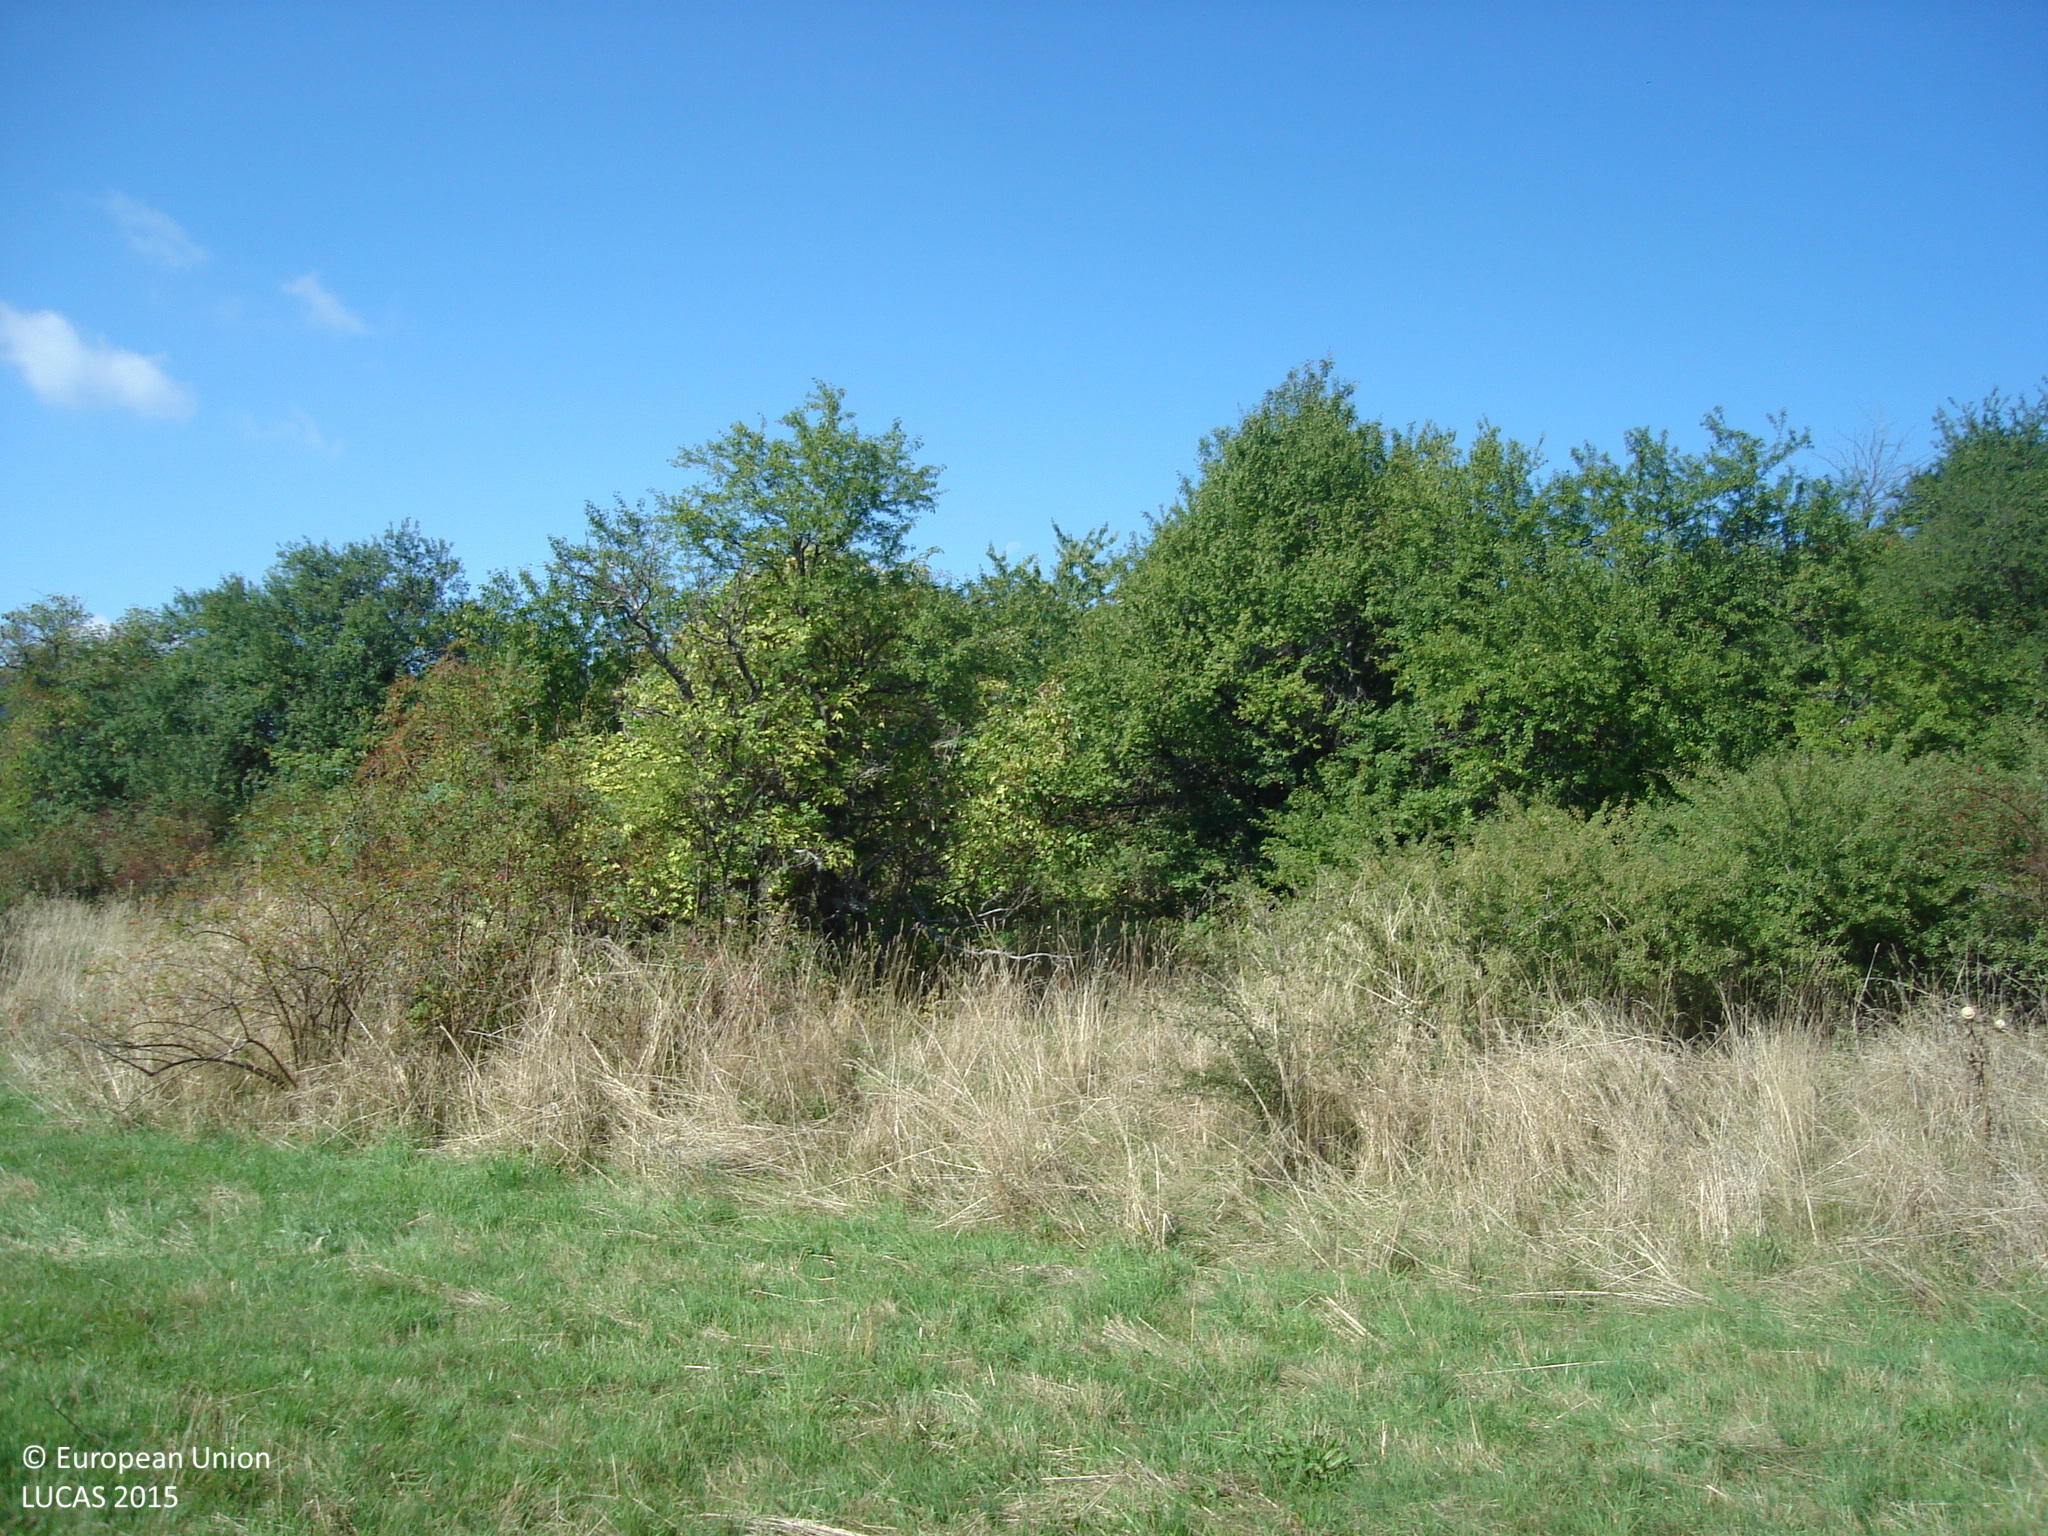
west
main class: Grassland
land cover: Grassland without tree/shrub cover
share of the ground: > 75 %
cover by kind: herbaceous plants 100 %
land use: Agriculture (excluding fallow land and kitchen gardens)
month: October
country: BG
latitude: 43.0727
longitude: 23.1393
